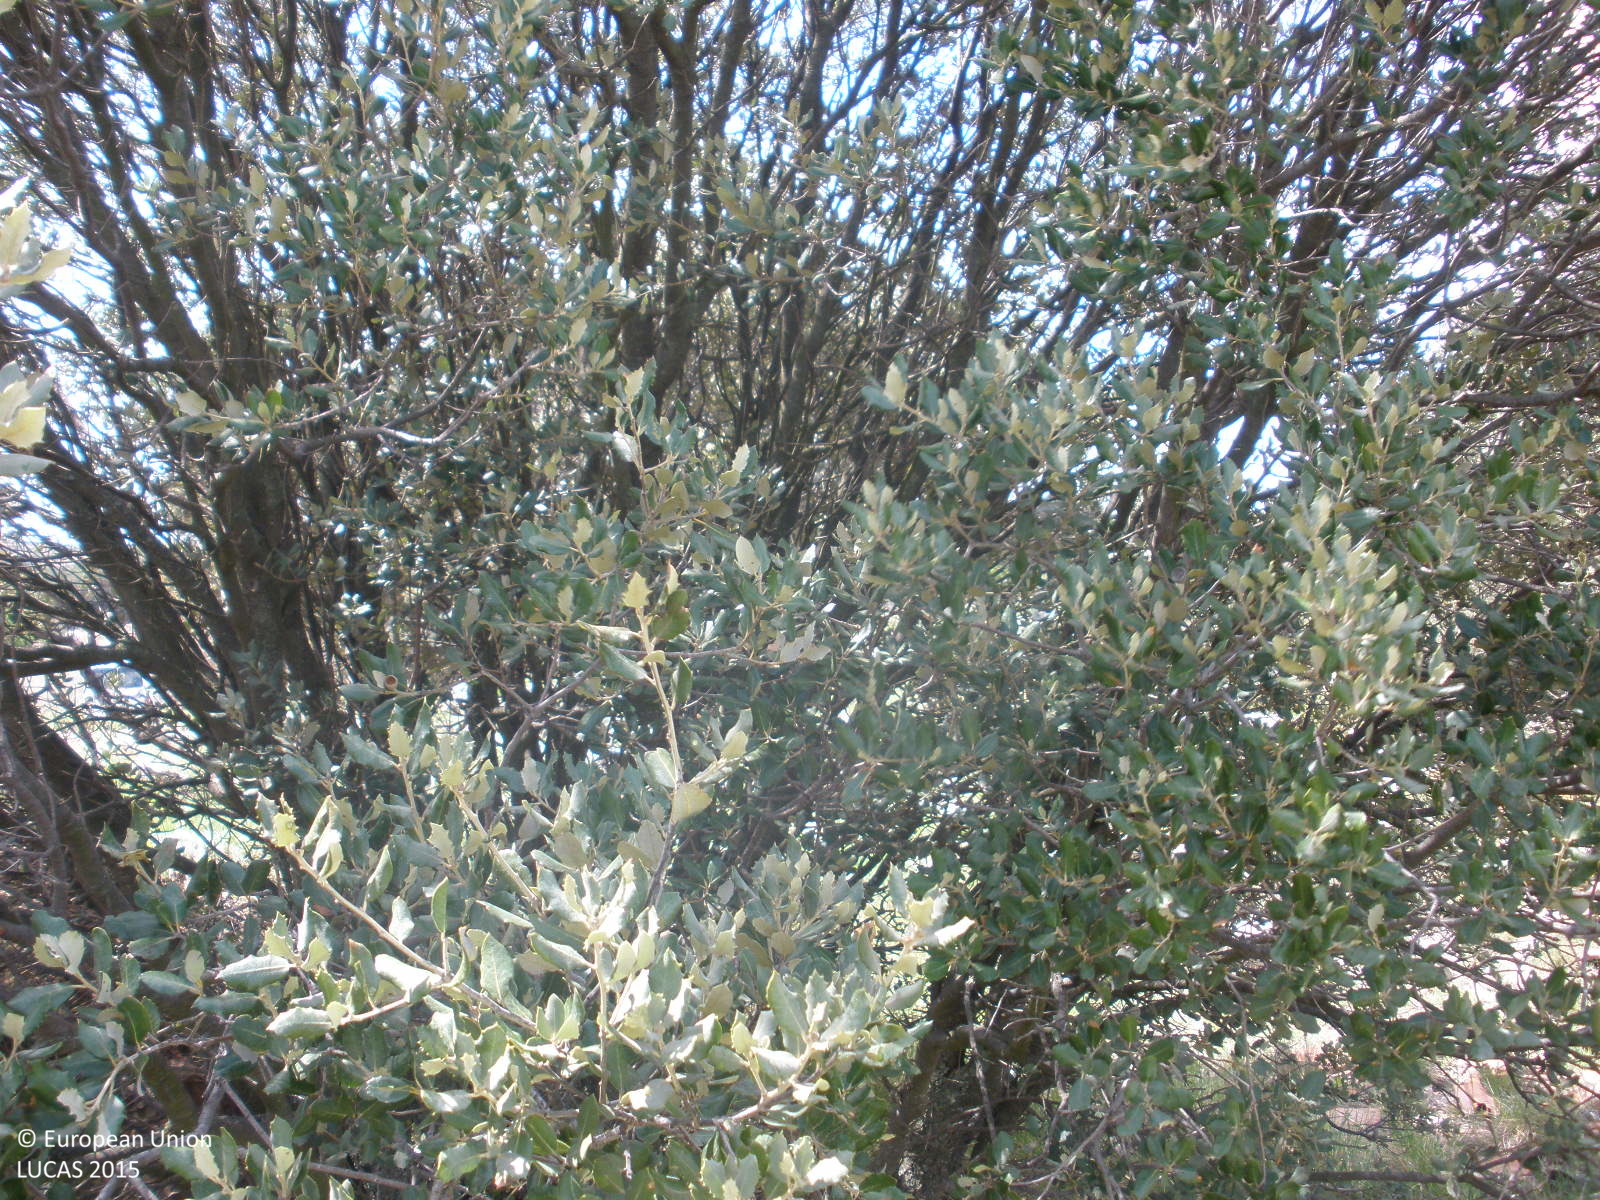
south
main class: Woodland
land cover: Broadleaved woodland
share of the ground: 10 - 25 %
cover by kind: herbaceous plants 70 %, broadleaved forest trees 20 %, consolidated bare surface 10 %
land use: Semi-natural and natural areas not in use
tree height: < 5 m
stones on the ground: < 10 %
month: April
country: ES
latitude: 40.2388
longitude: -0.7625
